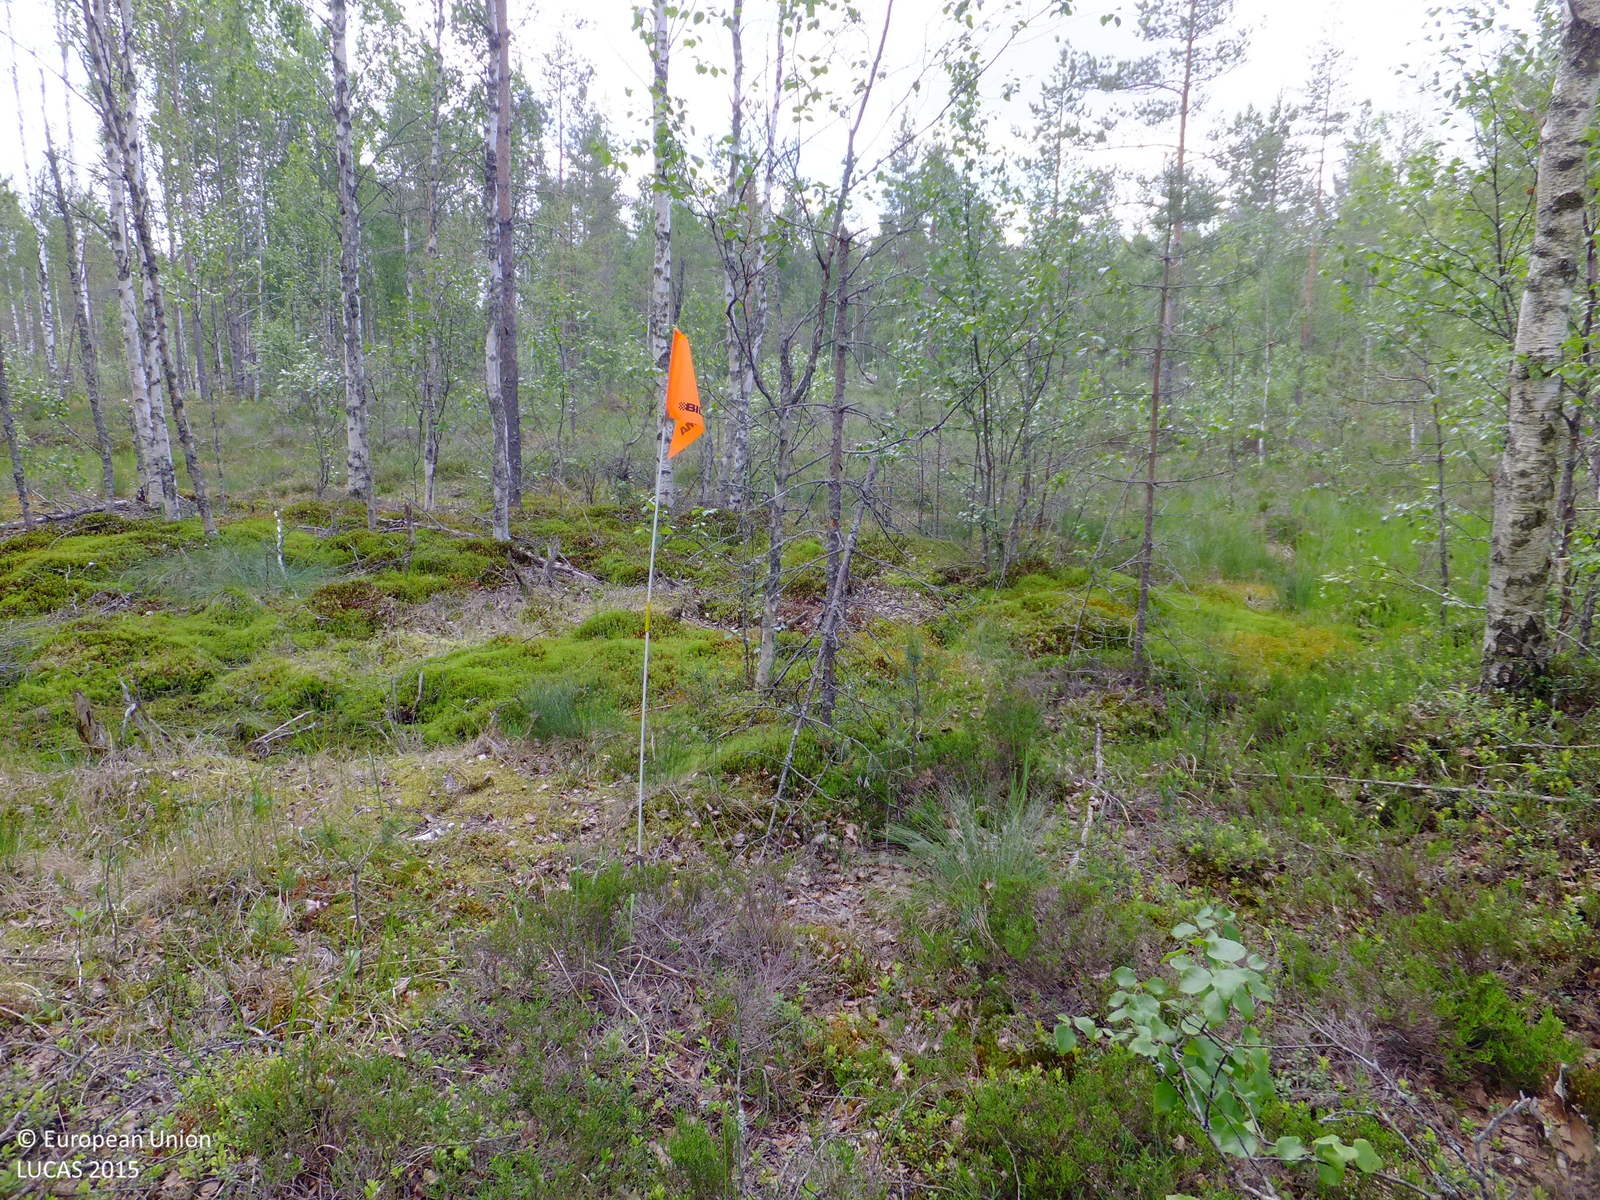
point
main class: Woodland
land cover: Pine dominated mixed woodland
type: boreal forest
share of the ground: 25 - 50 %
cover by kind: lichens and mosses 35 %, shrubs 20 %, herbaceous plants 20 %, broadleaved forest trees 15 %, coniferous forest trees 10 %
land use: Forestry
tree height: > 5 m
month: July
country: FI
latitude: 63.3706
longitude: 24.3770
